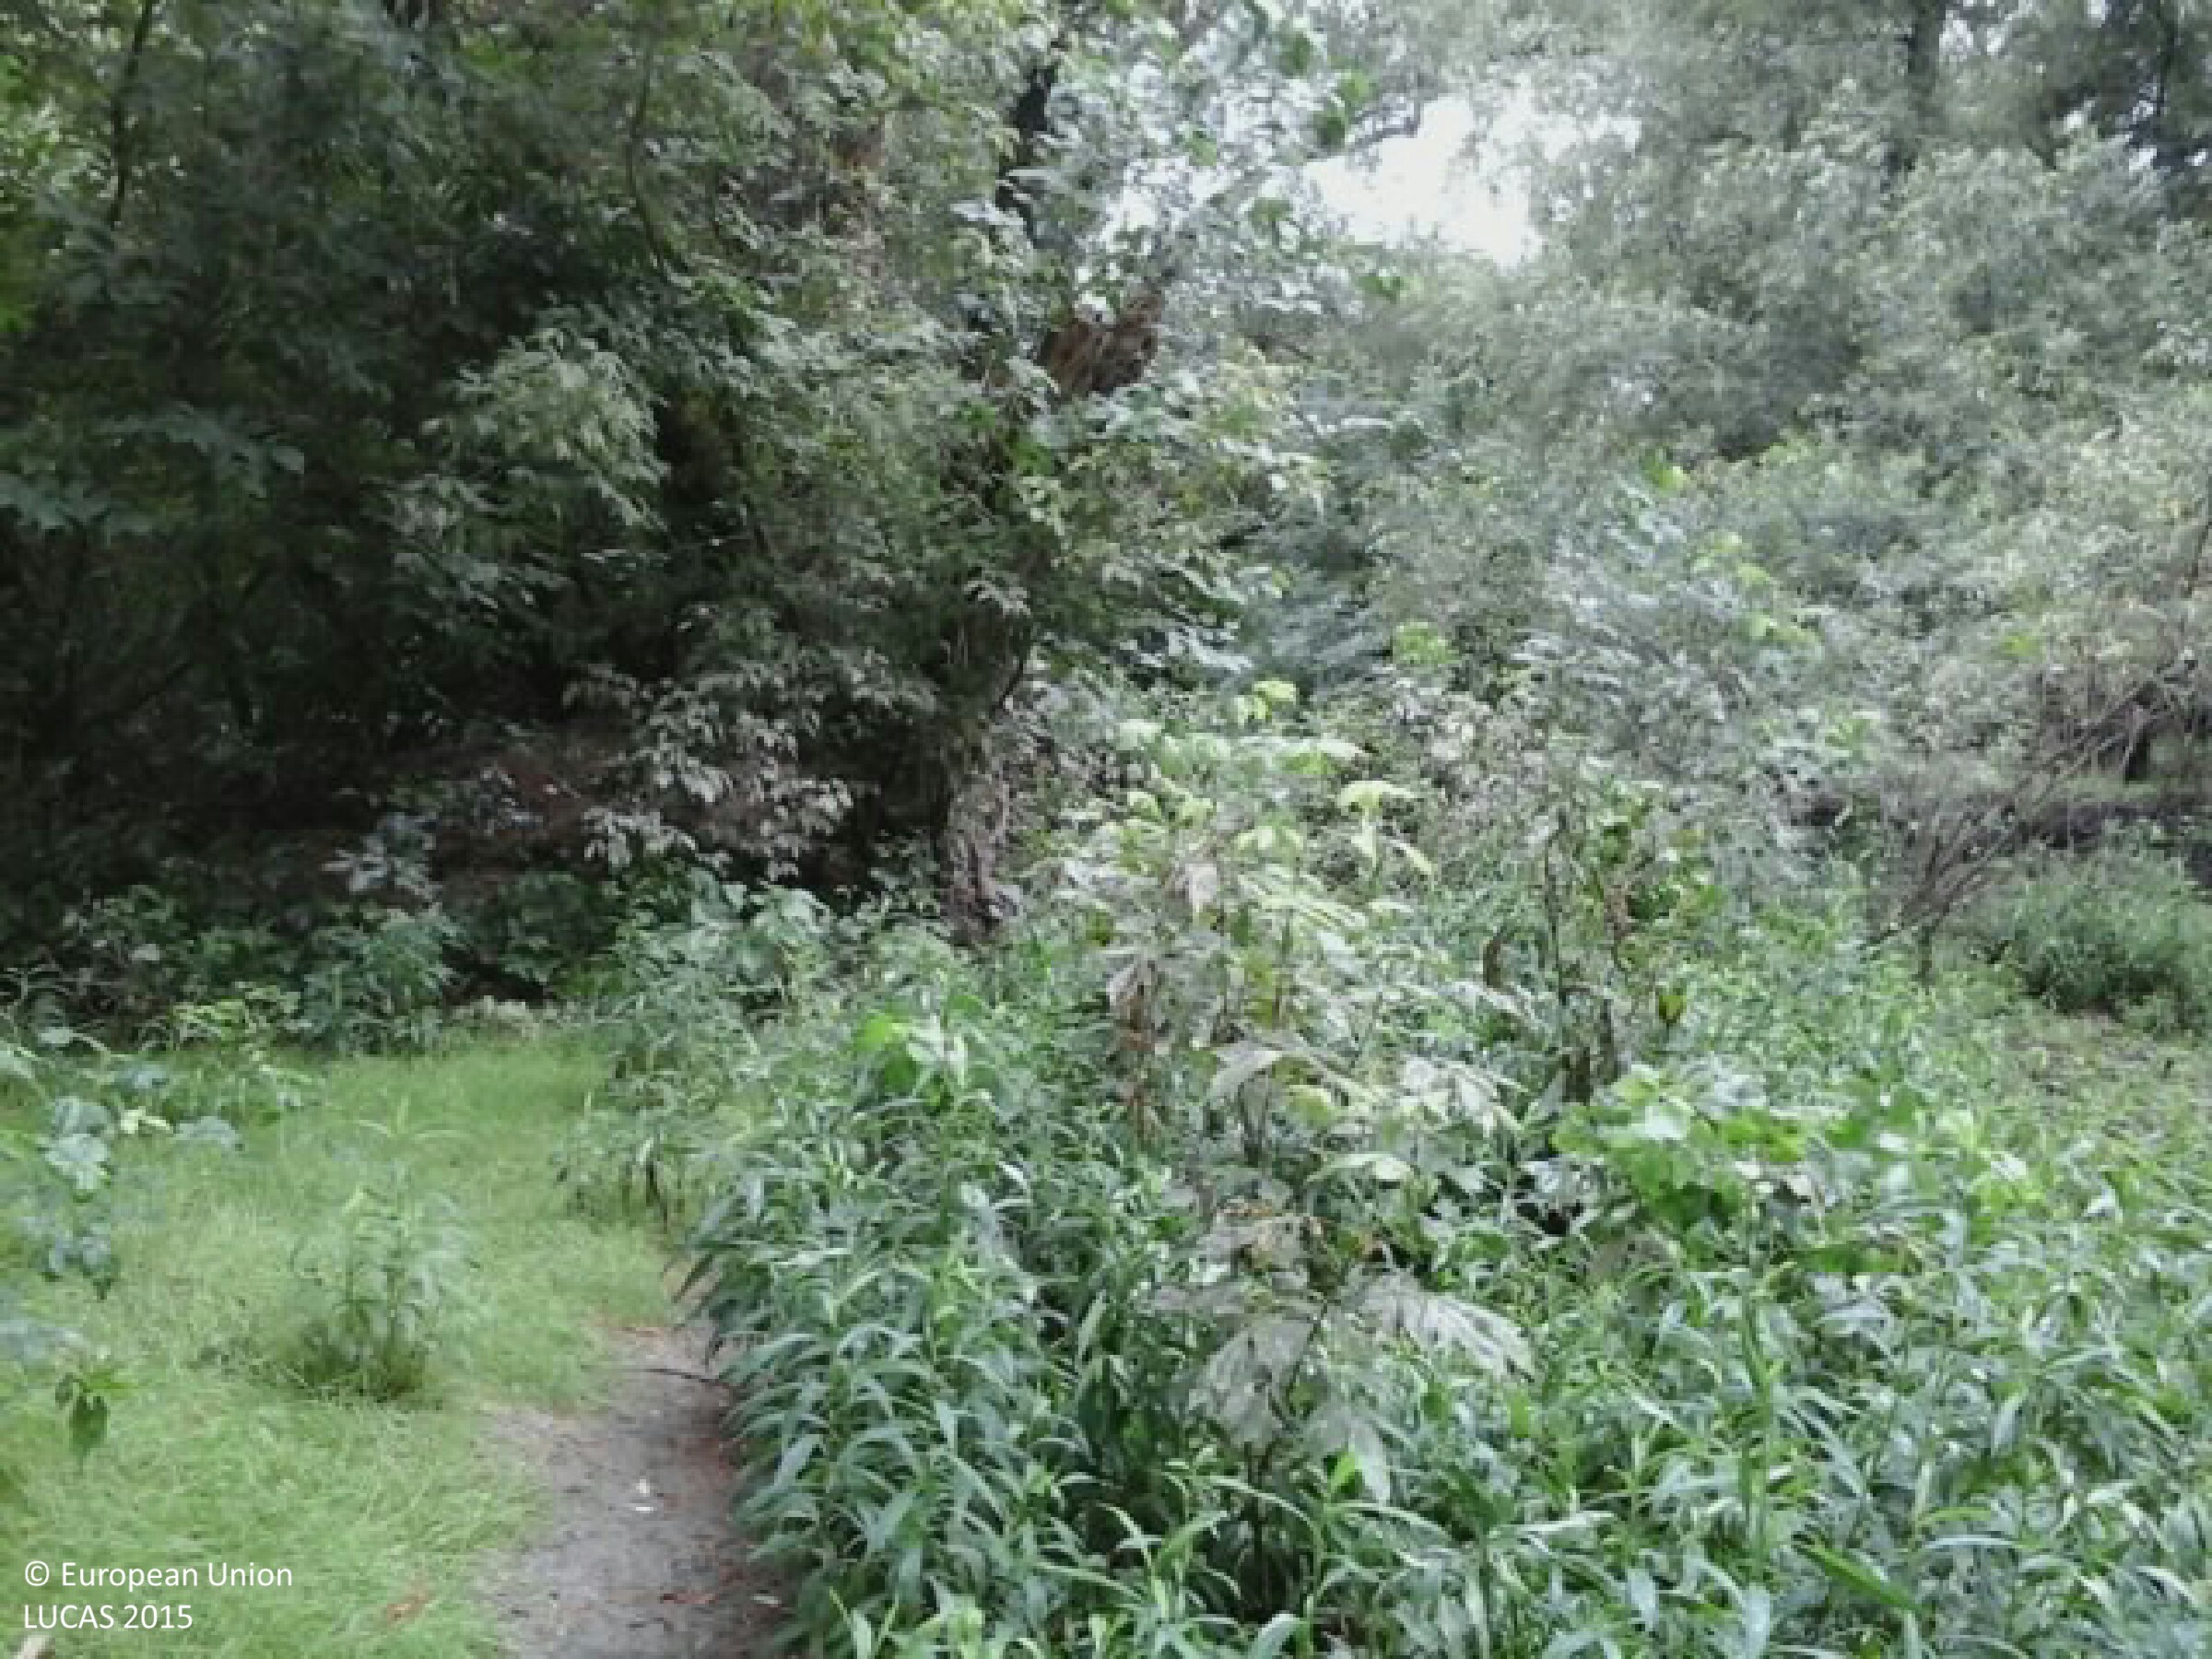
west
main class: Woodland
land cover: Broadleaved woodland
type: mesophytic deciduous forest
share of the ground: 50 - 75 %
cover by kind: broadleaved forest trees 60 %, shrubs 15 %, herbaceous plants 15 %, unconsolidated bare surface 10 %
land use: Forestry
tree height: > 5 m
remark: Temporary dry
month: July
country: HU
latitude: 46.4860
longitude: 18.9103
